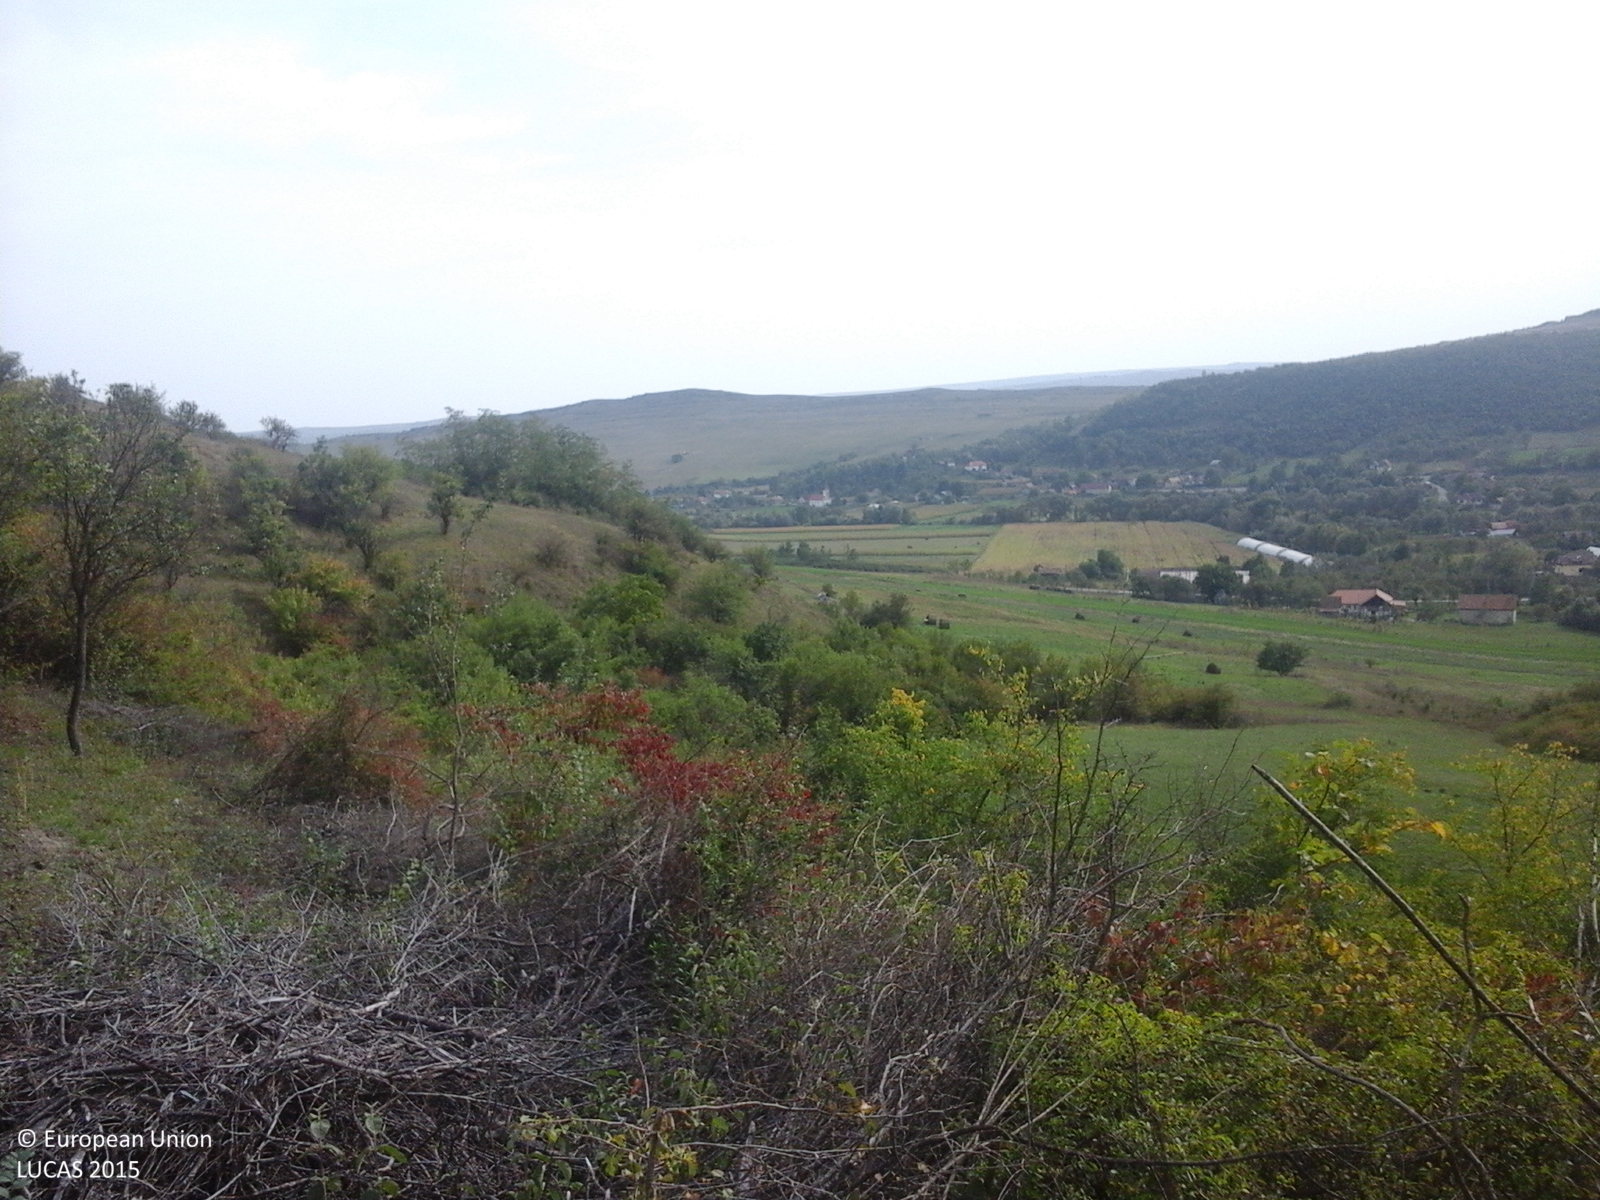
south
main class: Shrubland
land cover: Shrubland with sparse tree cover
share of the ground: > 75 %
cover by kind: herbaceous plants 85 %, shrubs 10 %, broadleaved forest trees 5 %
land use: Fallow land
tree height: < 5 m
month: September
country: RO
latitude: 46.9536
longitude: 23.6198
